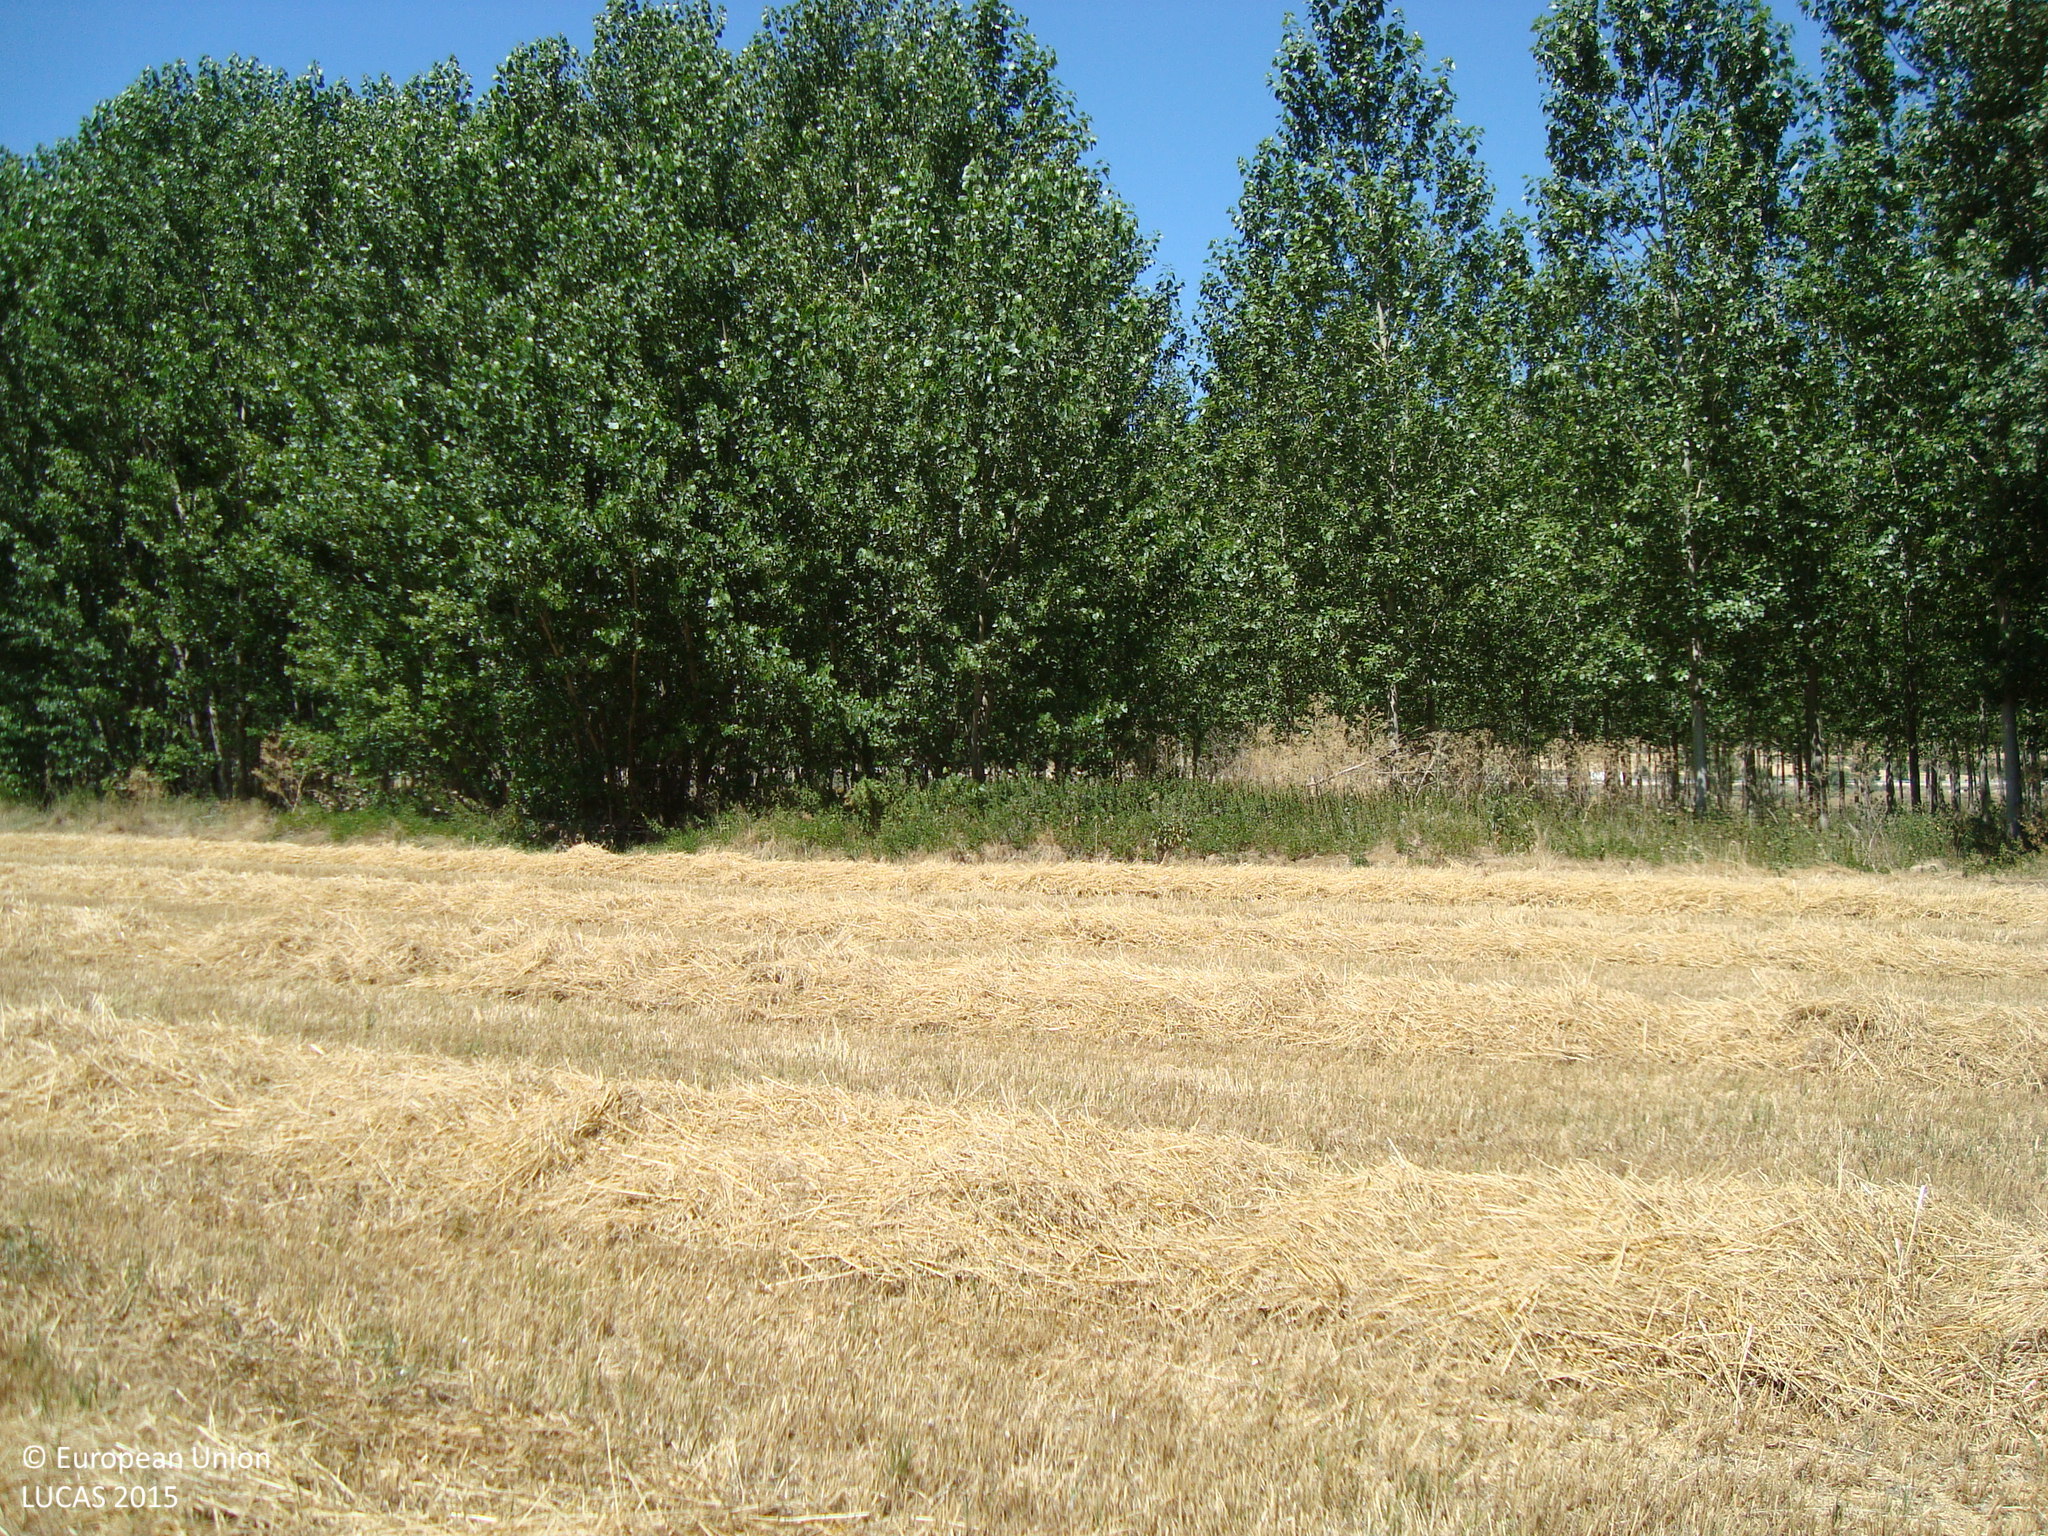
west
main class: Cropland
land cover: Common wheat
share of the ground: < 10 %
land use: Agriculture (excluding fallow land and kitchen gardens)
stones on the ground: < 10 %
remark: Harvested field
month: July
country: ES
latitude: 42.2518
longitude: -3.9415
